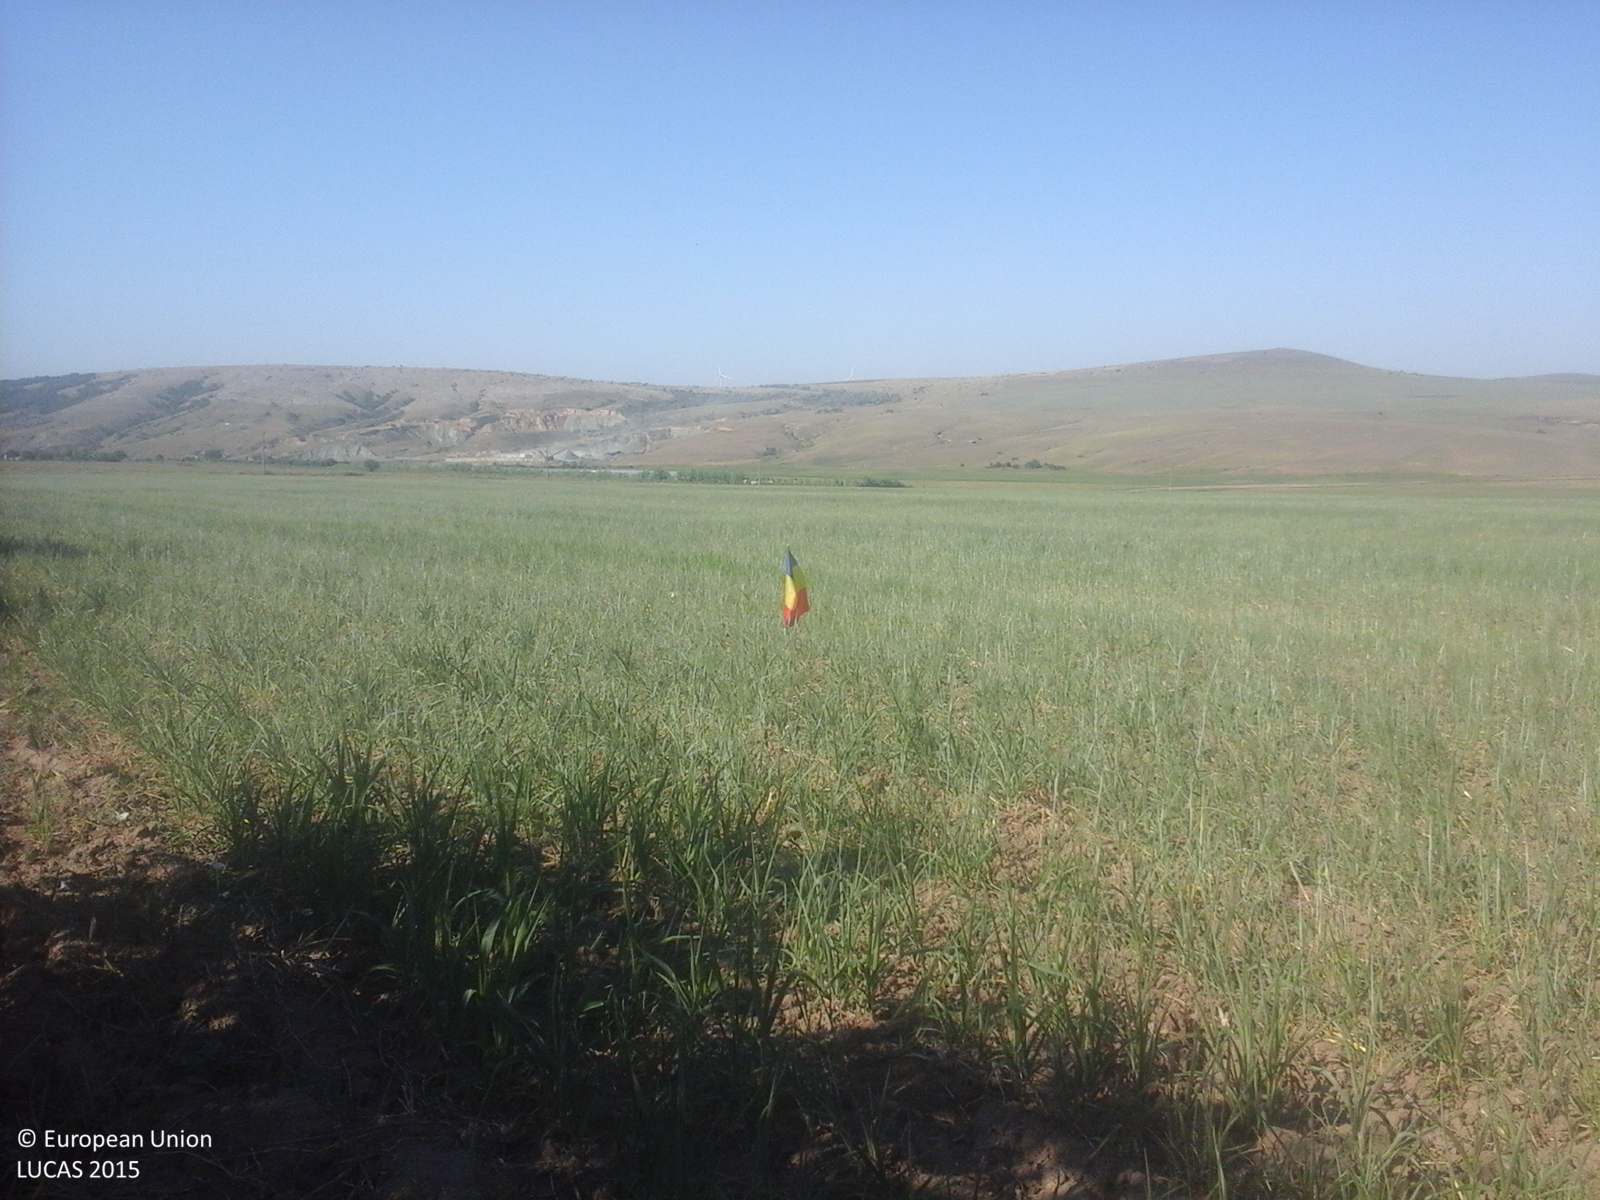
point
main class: Cropland
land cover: Other cereals
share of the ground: > 75 %
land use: Agriculture (excluding fallow land and kitchen gardens)
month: August
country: RO
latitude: 44.5285
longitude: 28.4299
